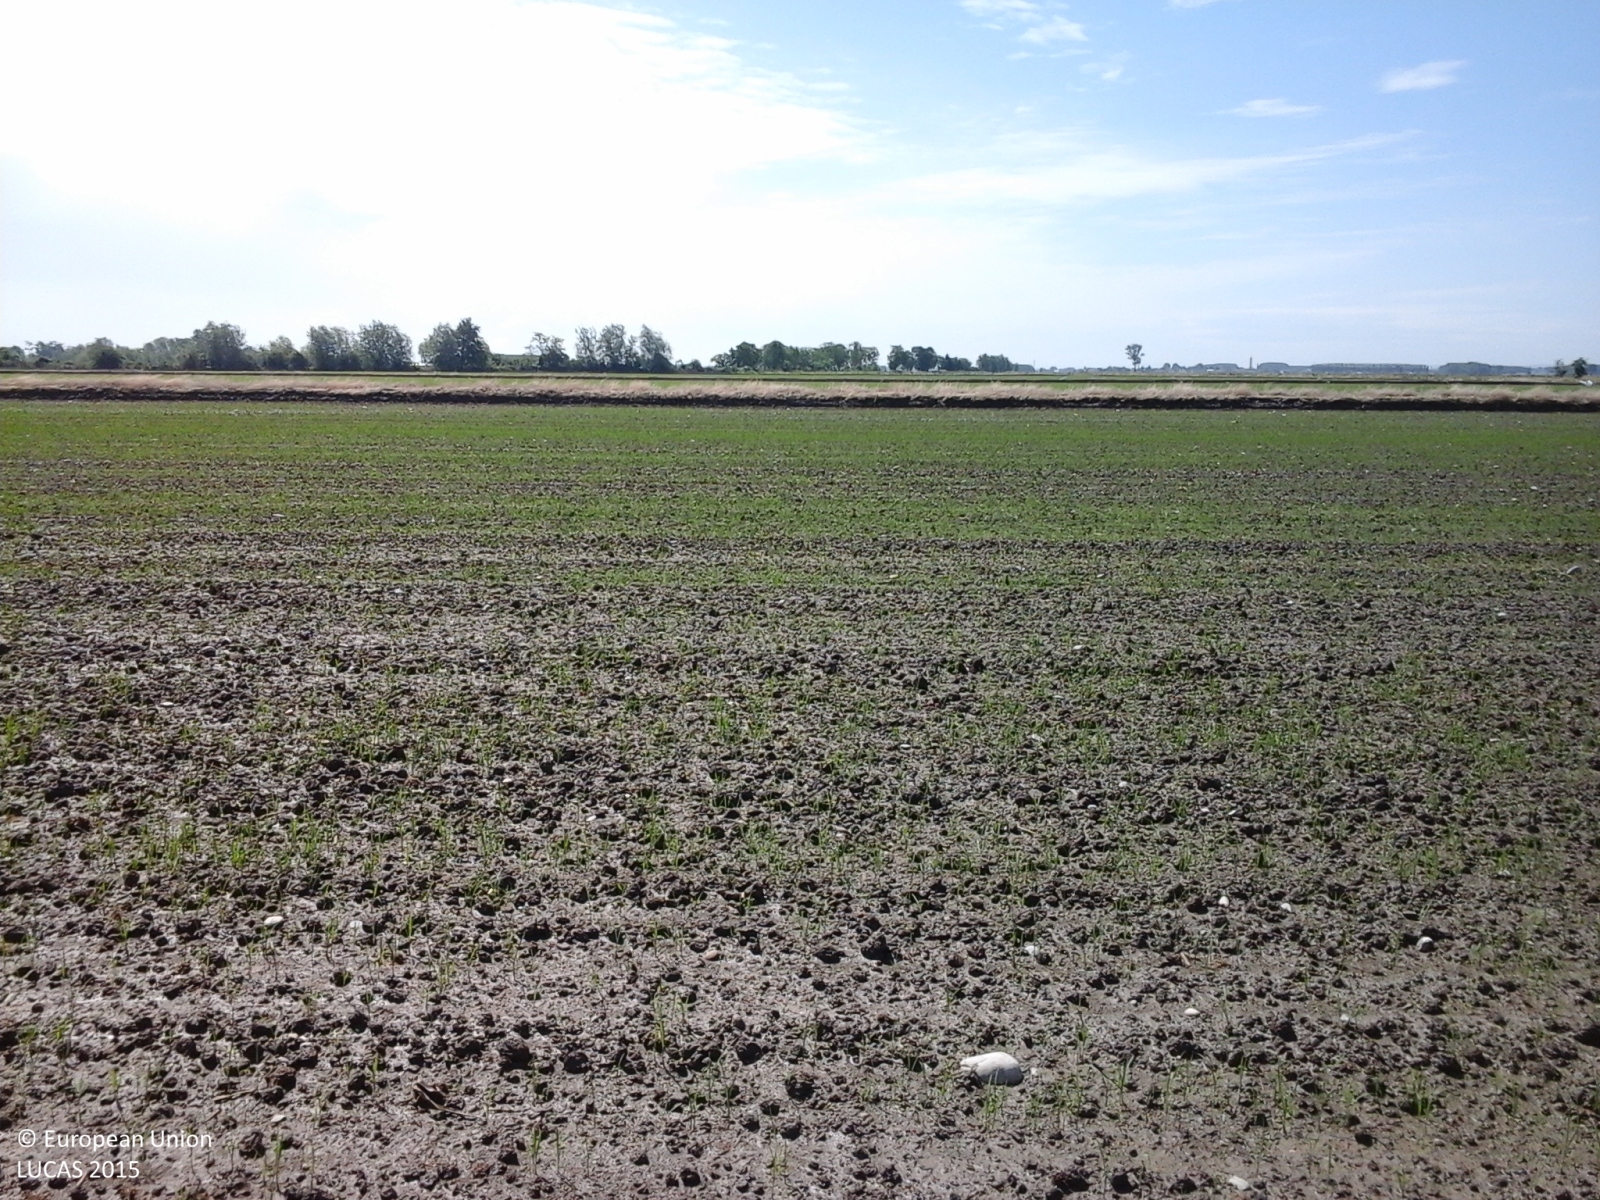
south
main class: Cropland
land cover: Rice
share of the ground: < 10 %
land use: Agriculture (excluding fallow land and kitchen gardens)
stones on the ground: < 10 %
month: May
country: IT
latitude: 45.4207
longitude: 8.4307
